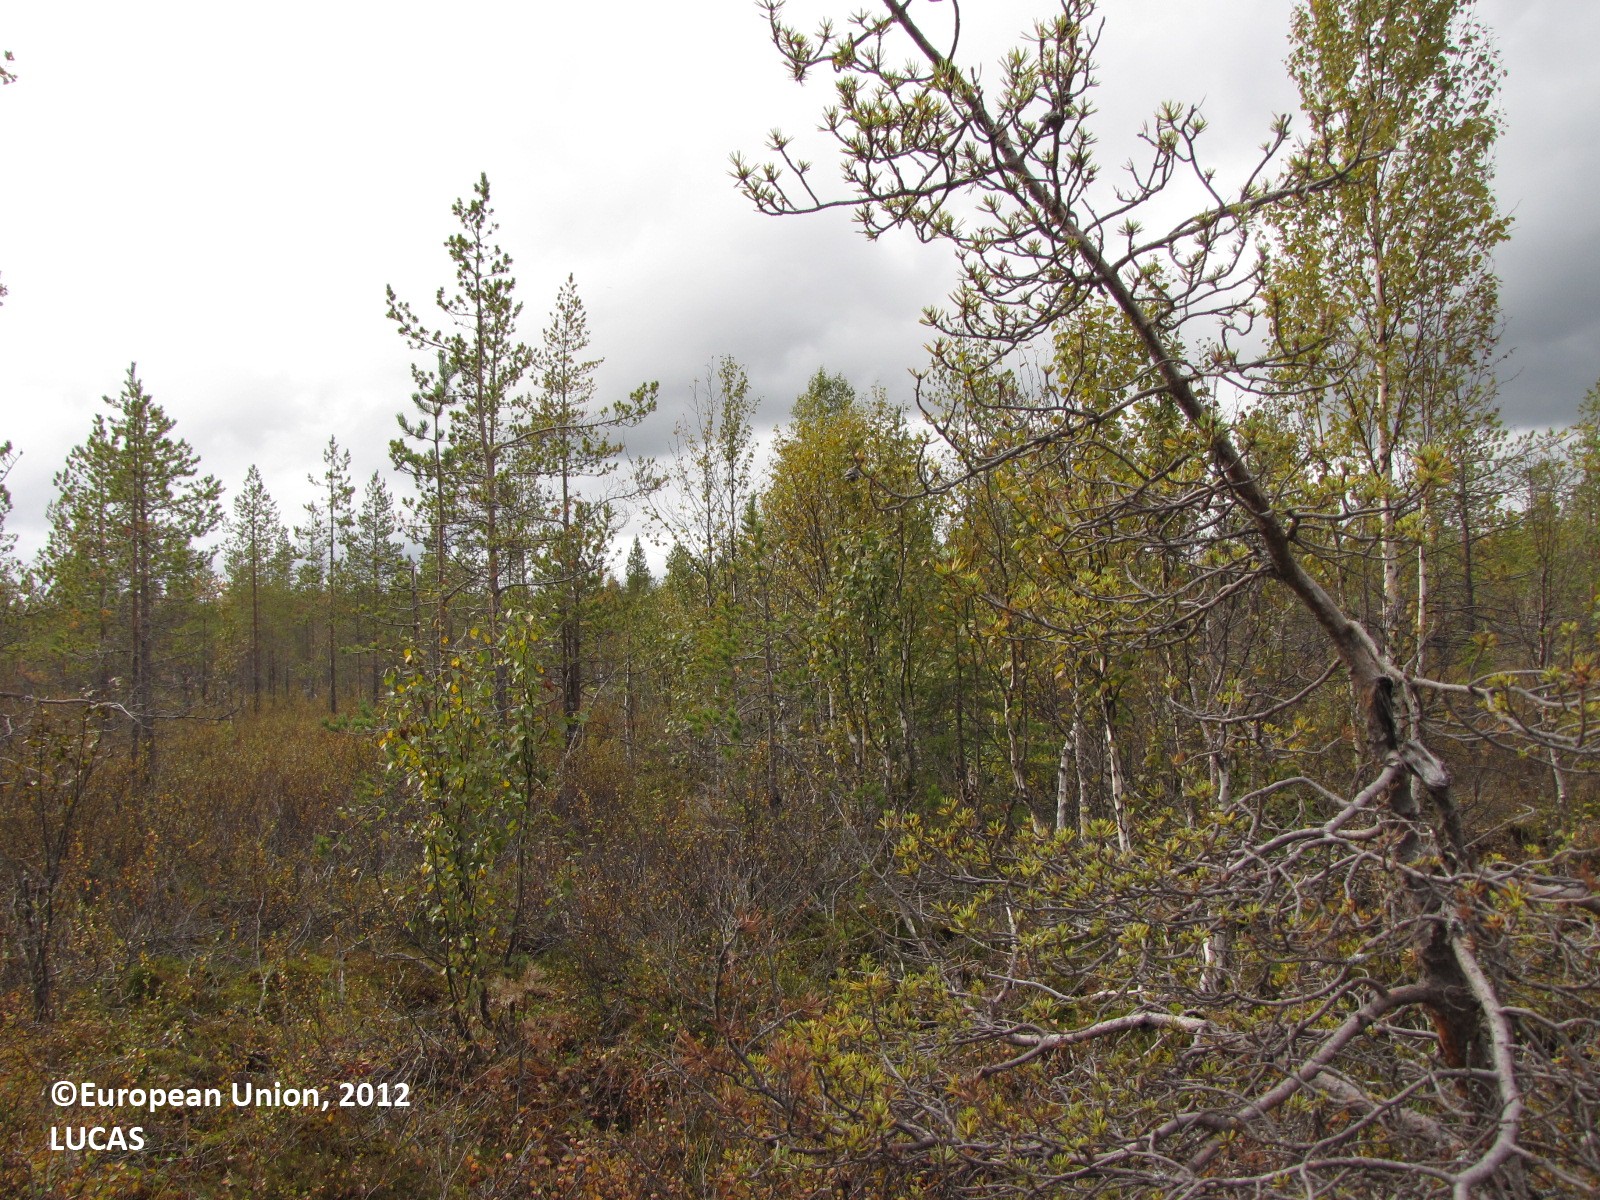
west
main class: Woodland
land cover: Pine dominated mixed woodland
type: boreal forest
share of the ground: 25 - 50 %
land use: Forestry
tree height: > 5 m
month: September
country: FI
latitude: 67.2227
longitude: 23.9838
